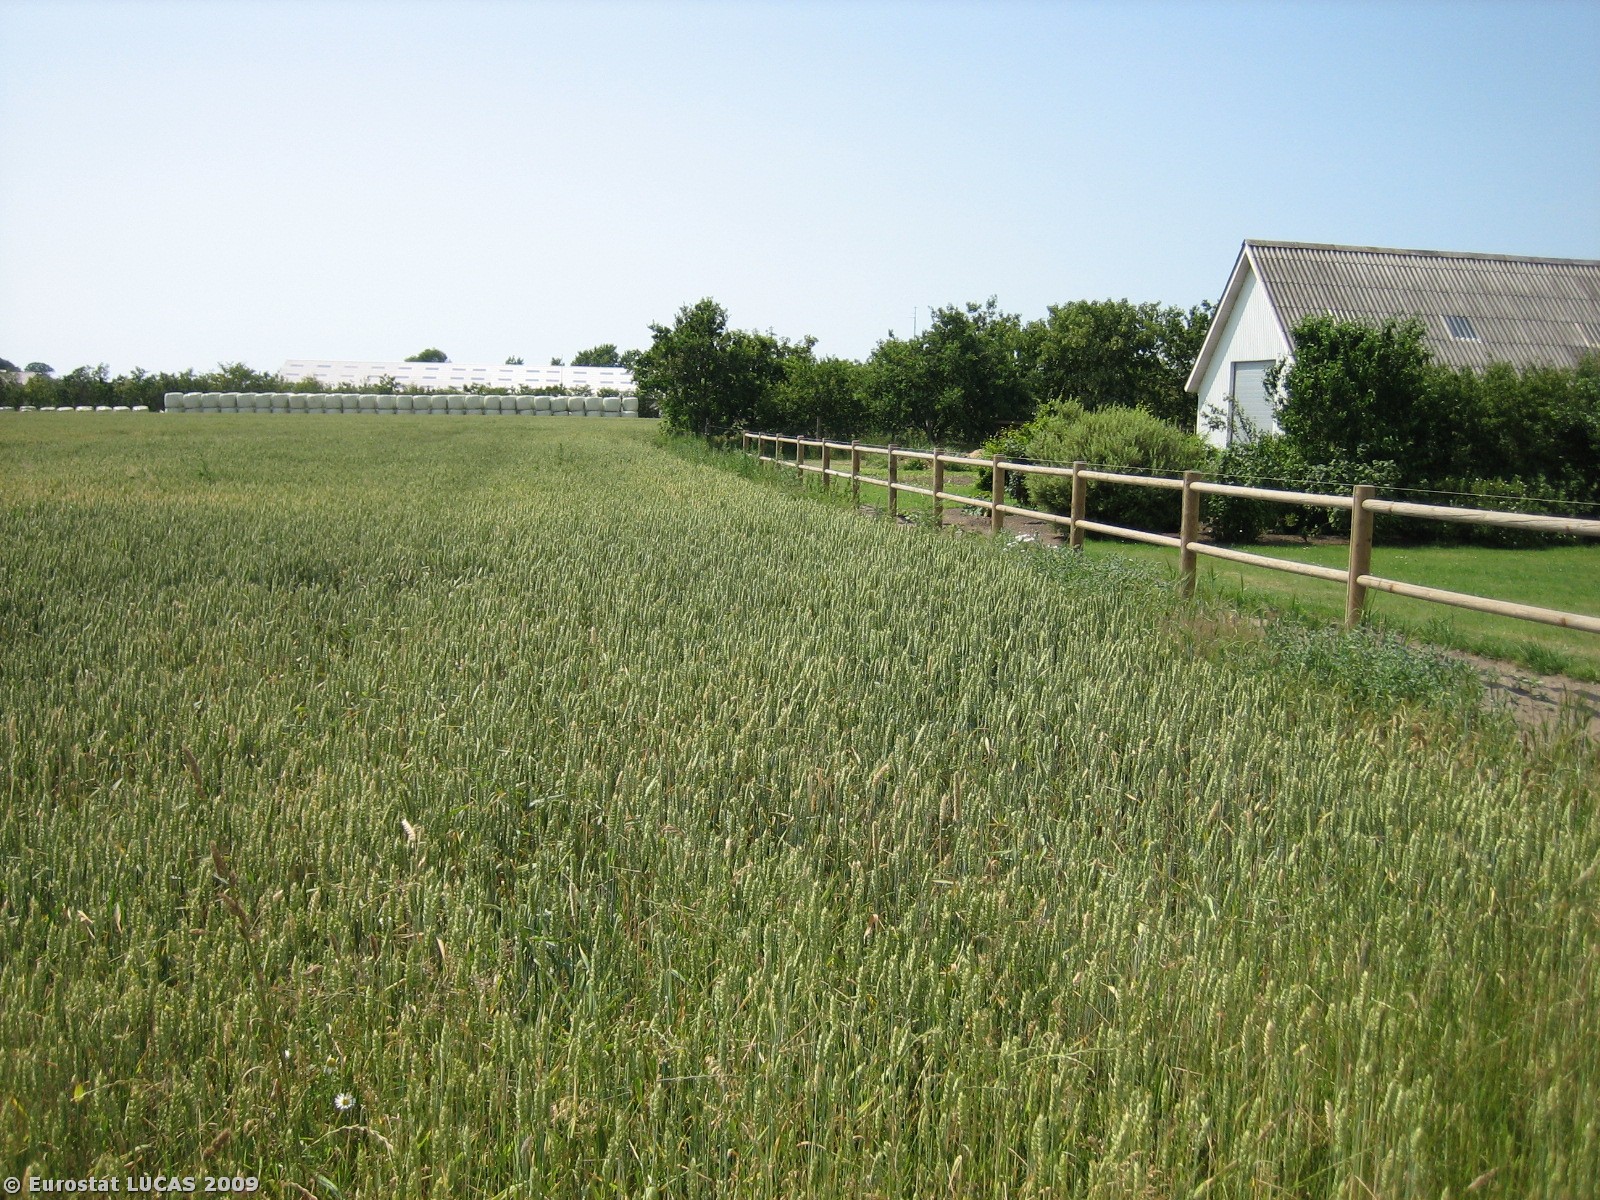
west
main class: Cropland
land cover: Common wheat
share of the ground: > 75 %
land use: Agriculture (excluding fallow land and kitchen gardens)
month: July
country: DK
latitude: 55.3904
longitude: 8.7224
